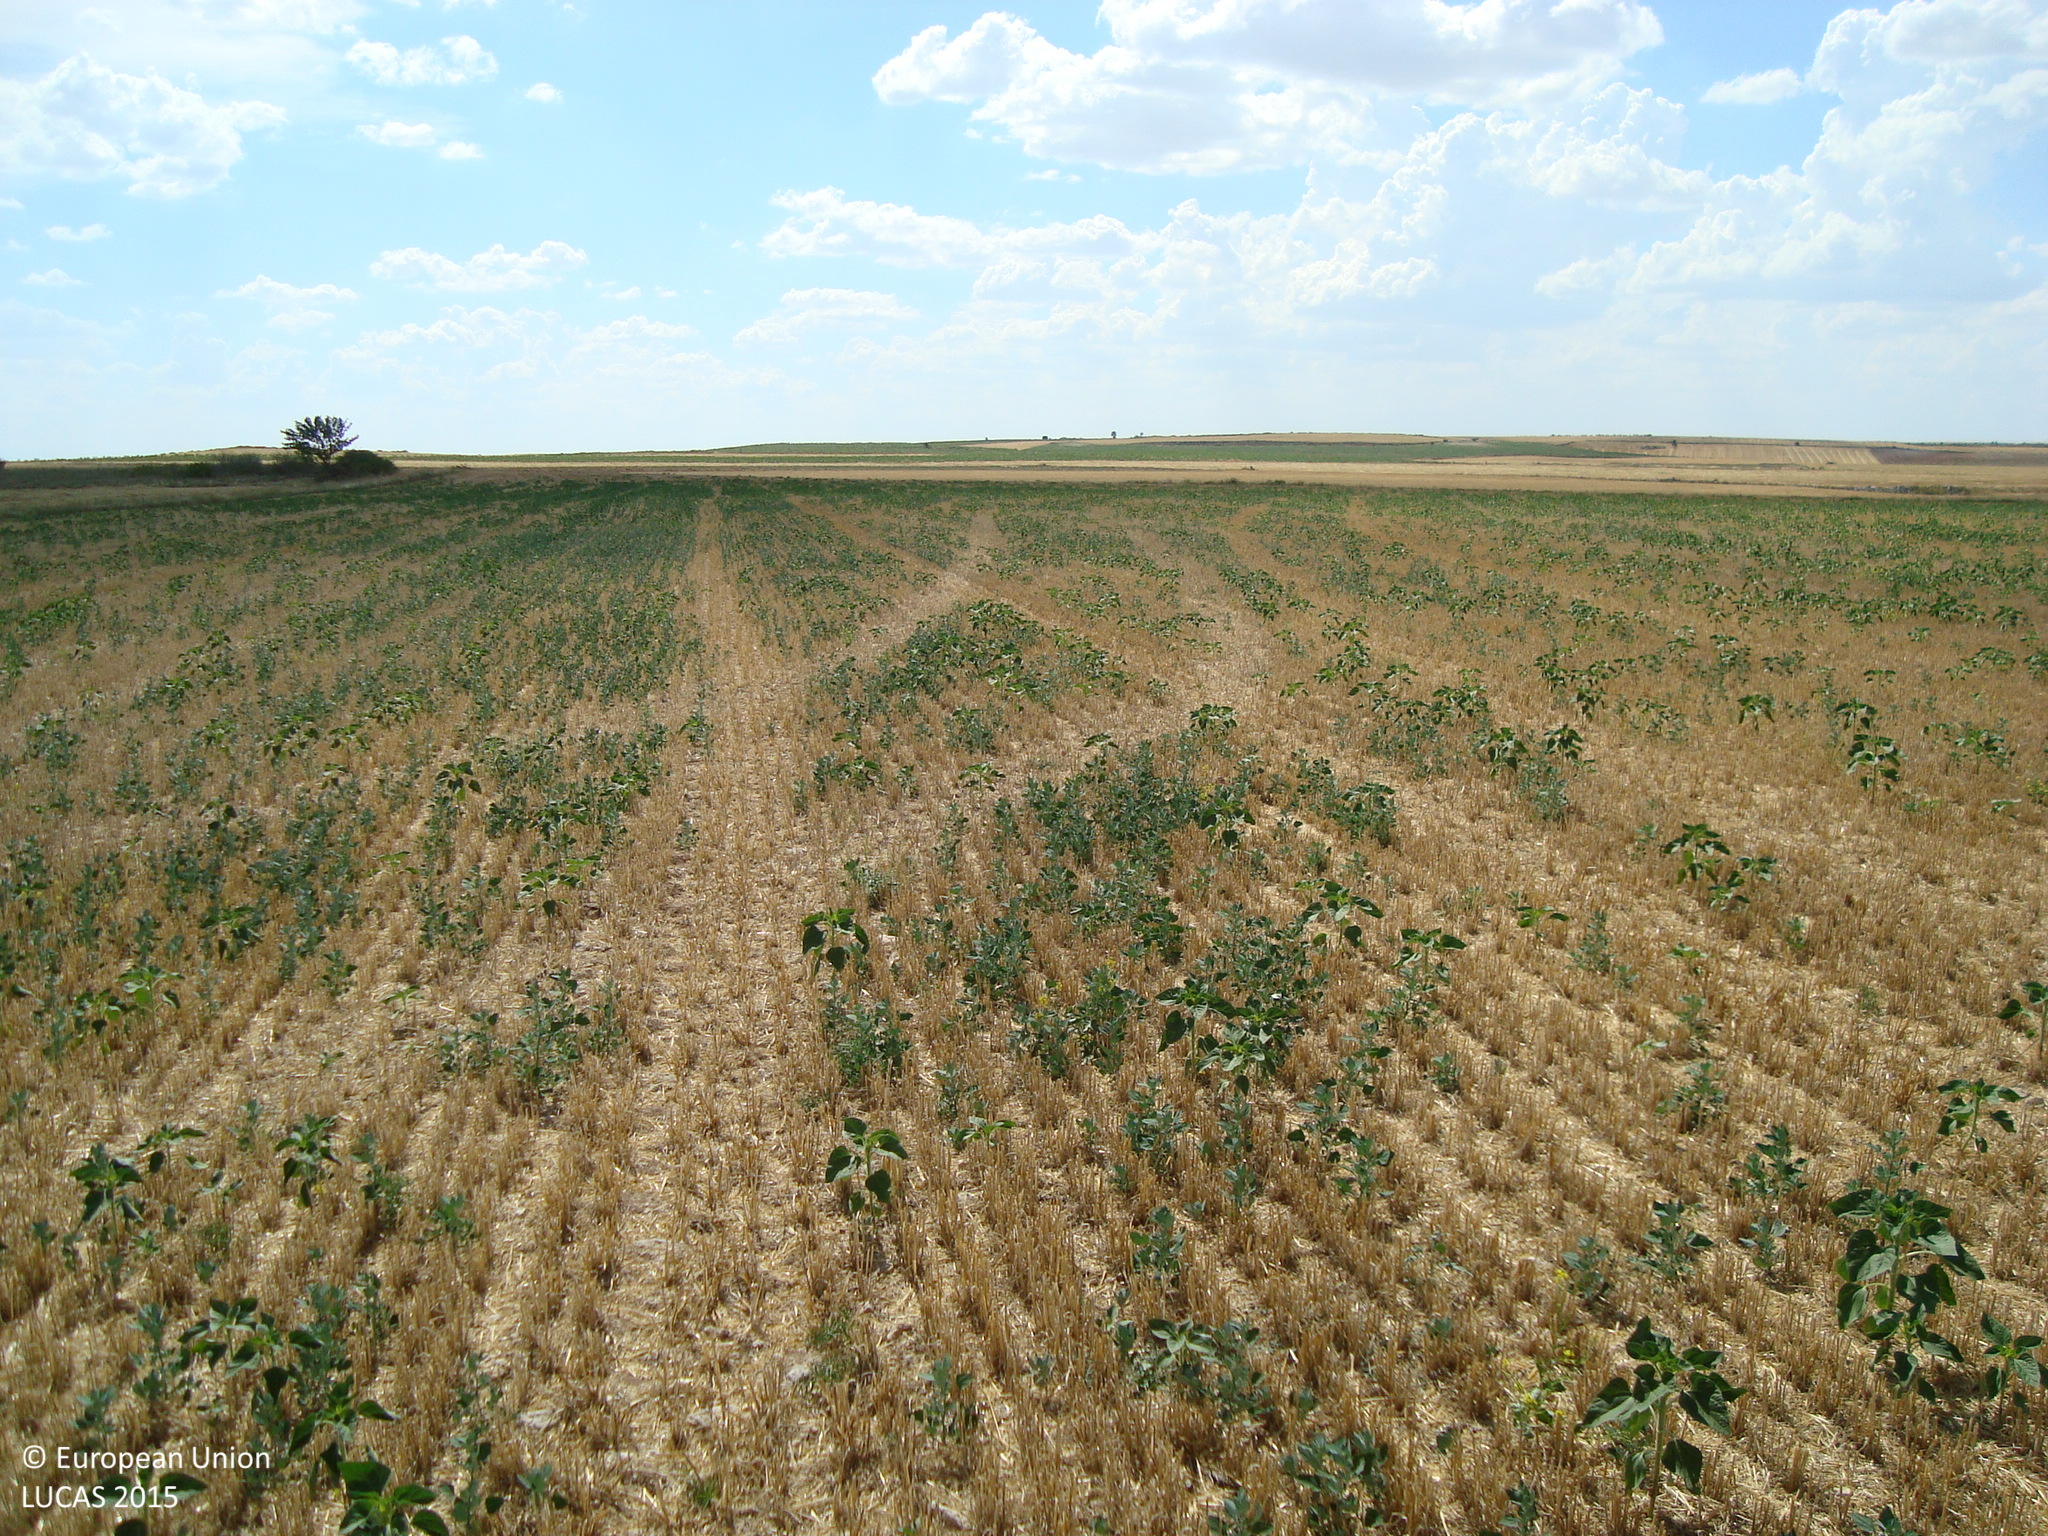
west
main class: Cropland
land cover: Barley
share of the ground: < 10 %
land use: Agriculture (excluding fallow land and kitchen gardens)
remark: Harvested field
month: July
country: ES
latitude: 42.0148
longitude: -3.9353
